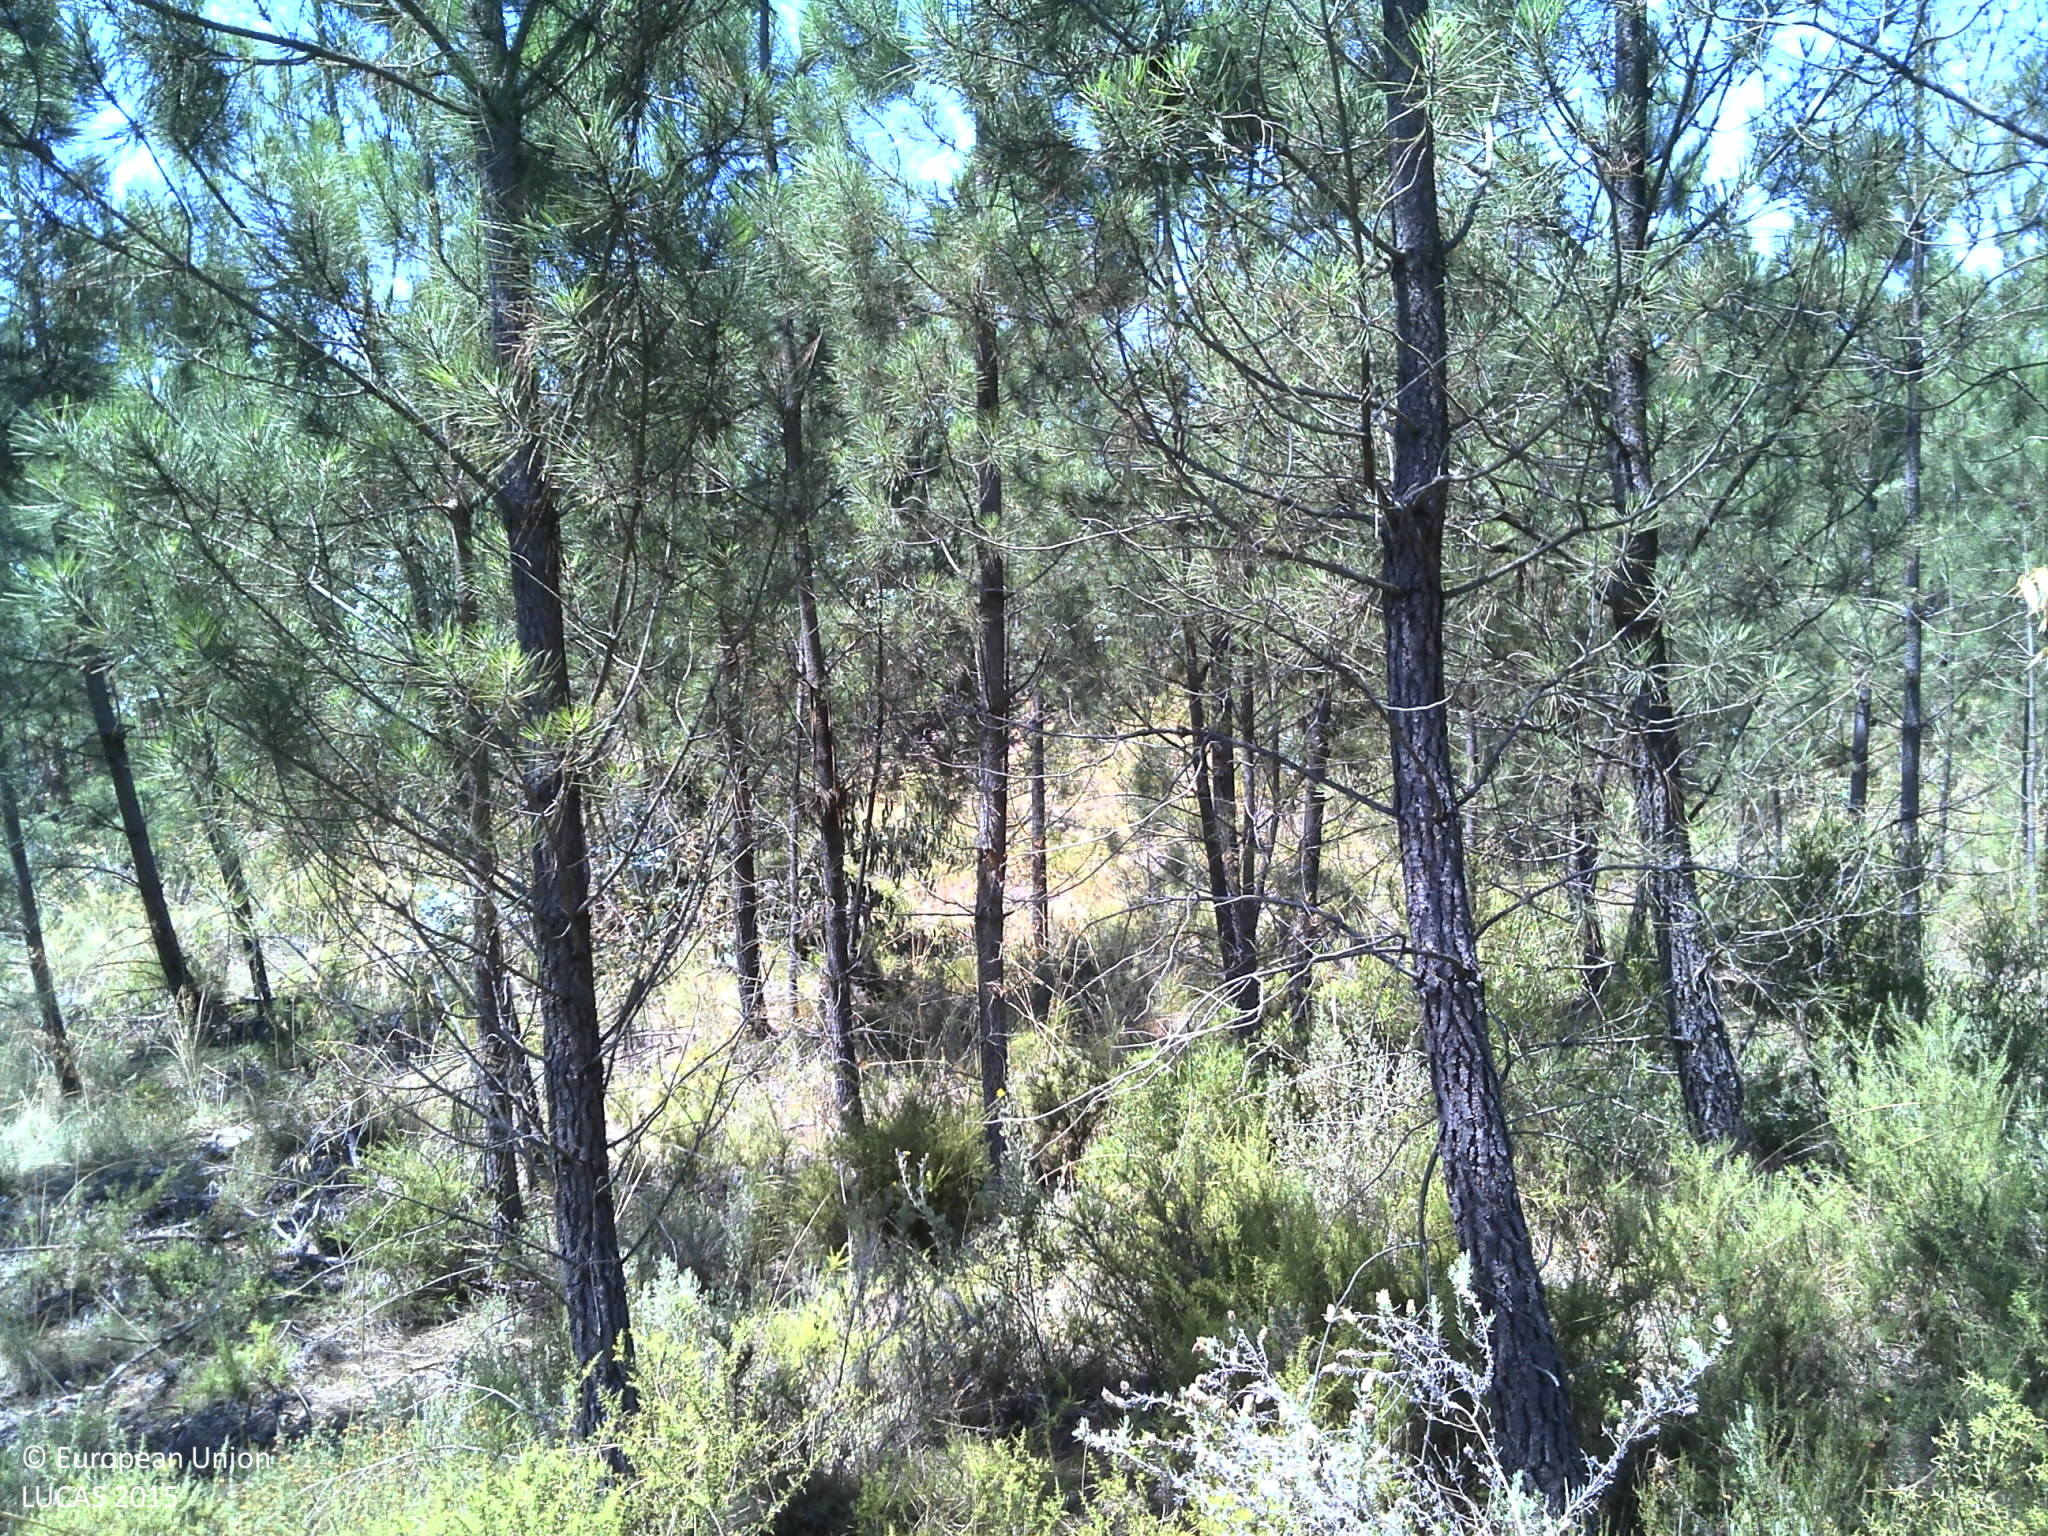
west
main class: Woodland
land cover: Pine dominated coniferous woodland
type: coniferous forest of the mediterranean region
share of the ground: 25 - 50 %
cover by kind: coniferous forest trees 40 %, shrubs 30 %, unconsolidated bare surface 25 %, herbaceous plants 5 %
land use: Forestry
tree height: > 5 m
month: June
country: PT
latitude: 38.6027
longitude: -9.1457
